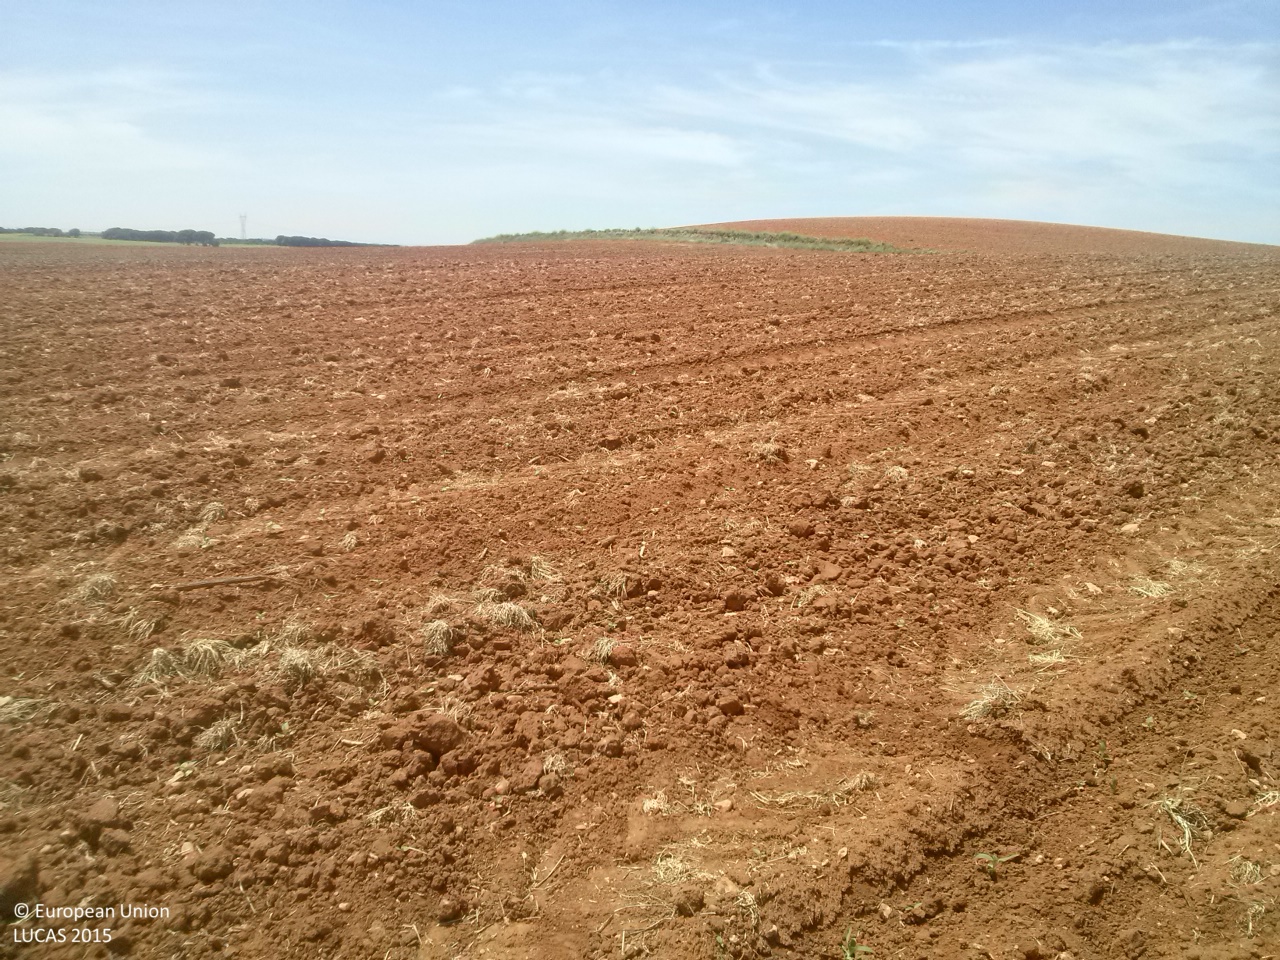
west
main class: Cropland
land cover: Sunflower
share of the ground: < 10 %
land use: Agriculture (excluding fallow land and kitchen gardens)
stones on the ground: 25 - 50 %
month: May
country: ES
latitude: 39.7580
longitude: -2.4929
